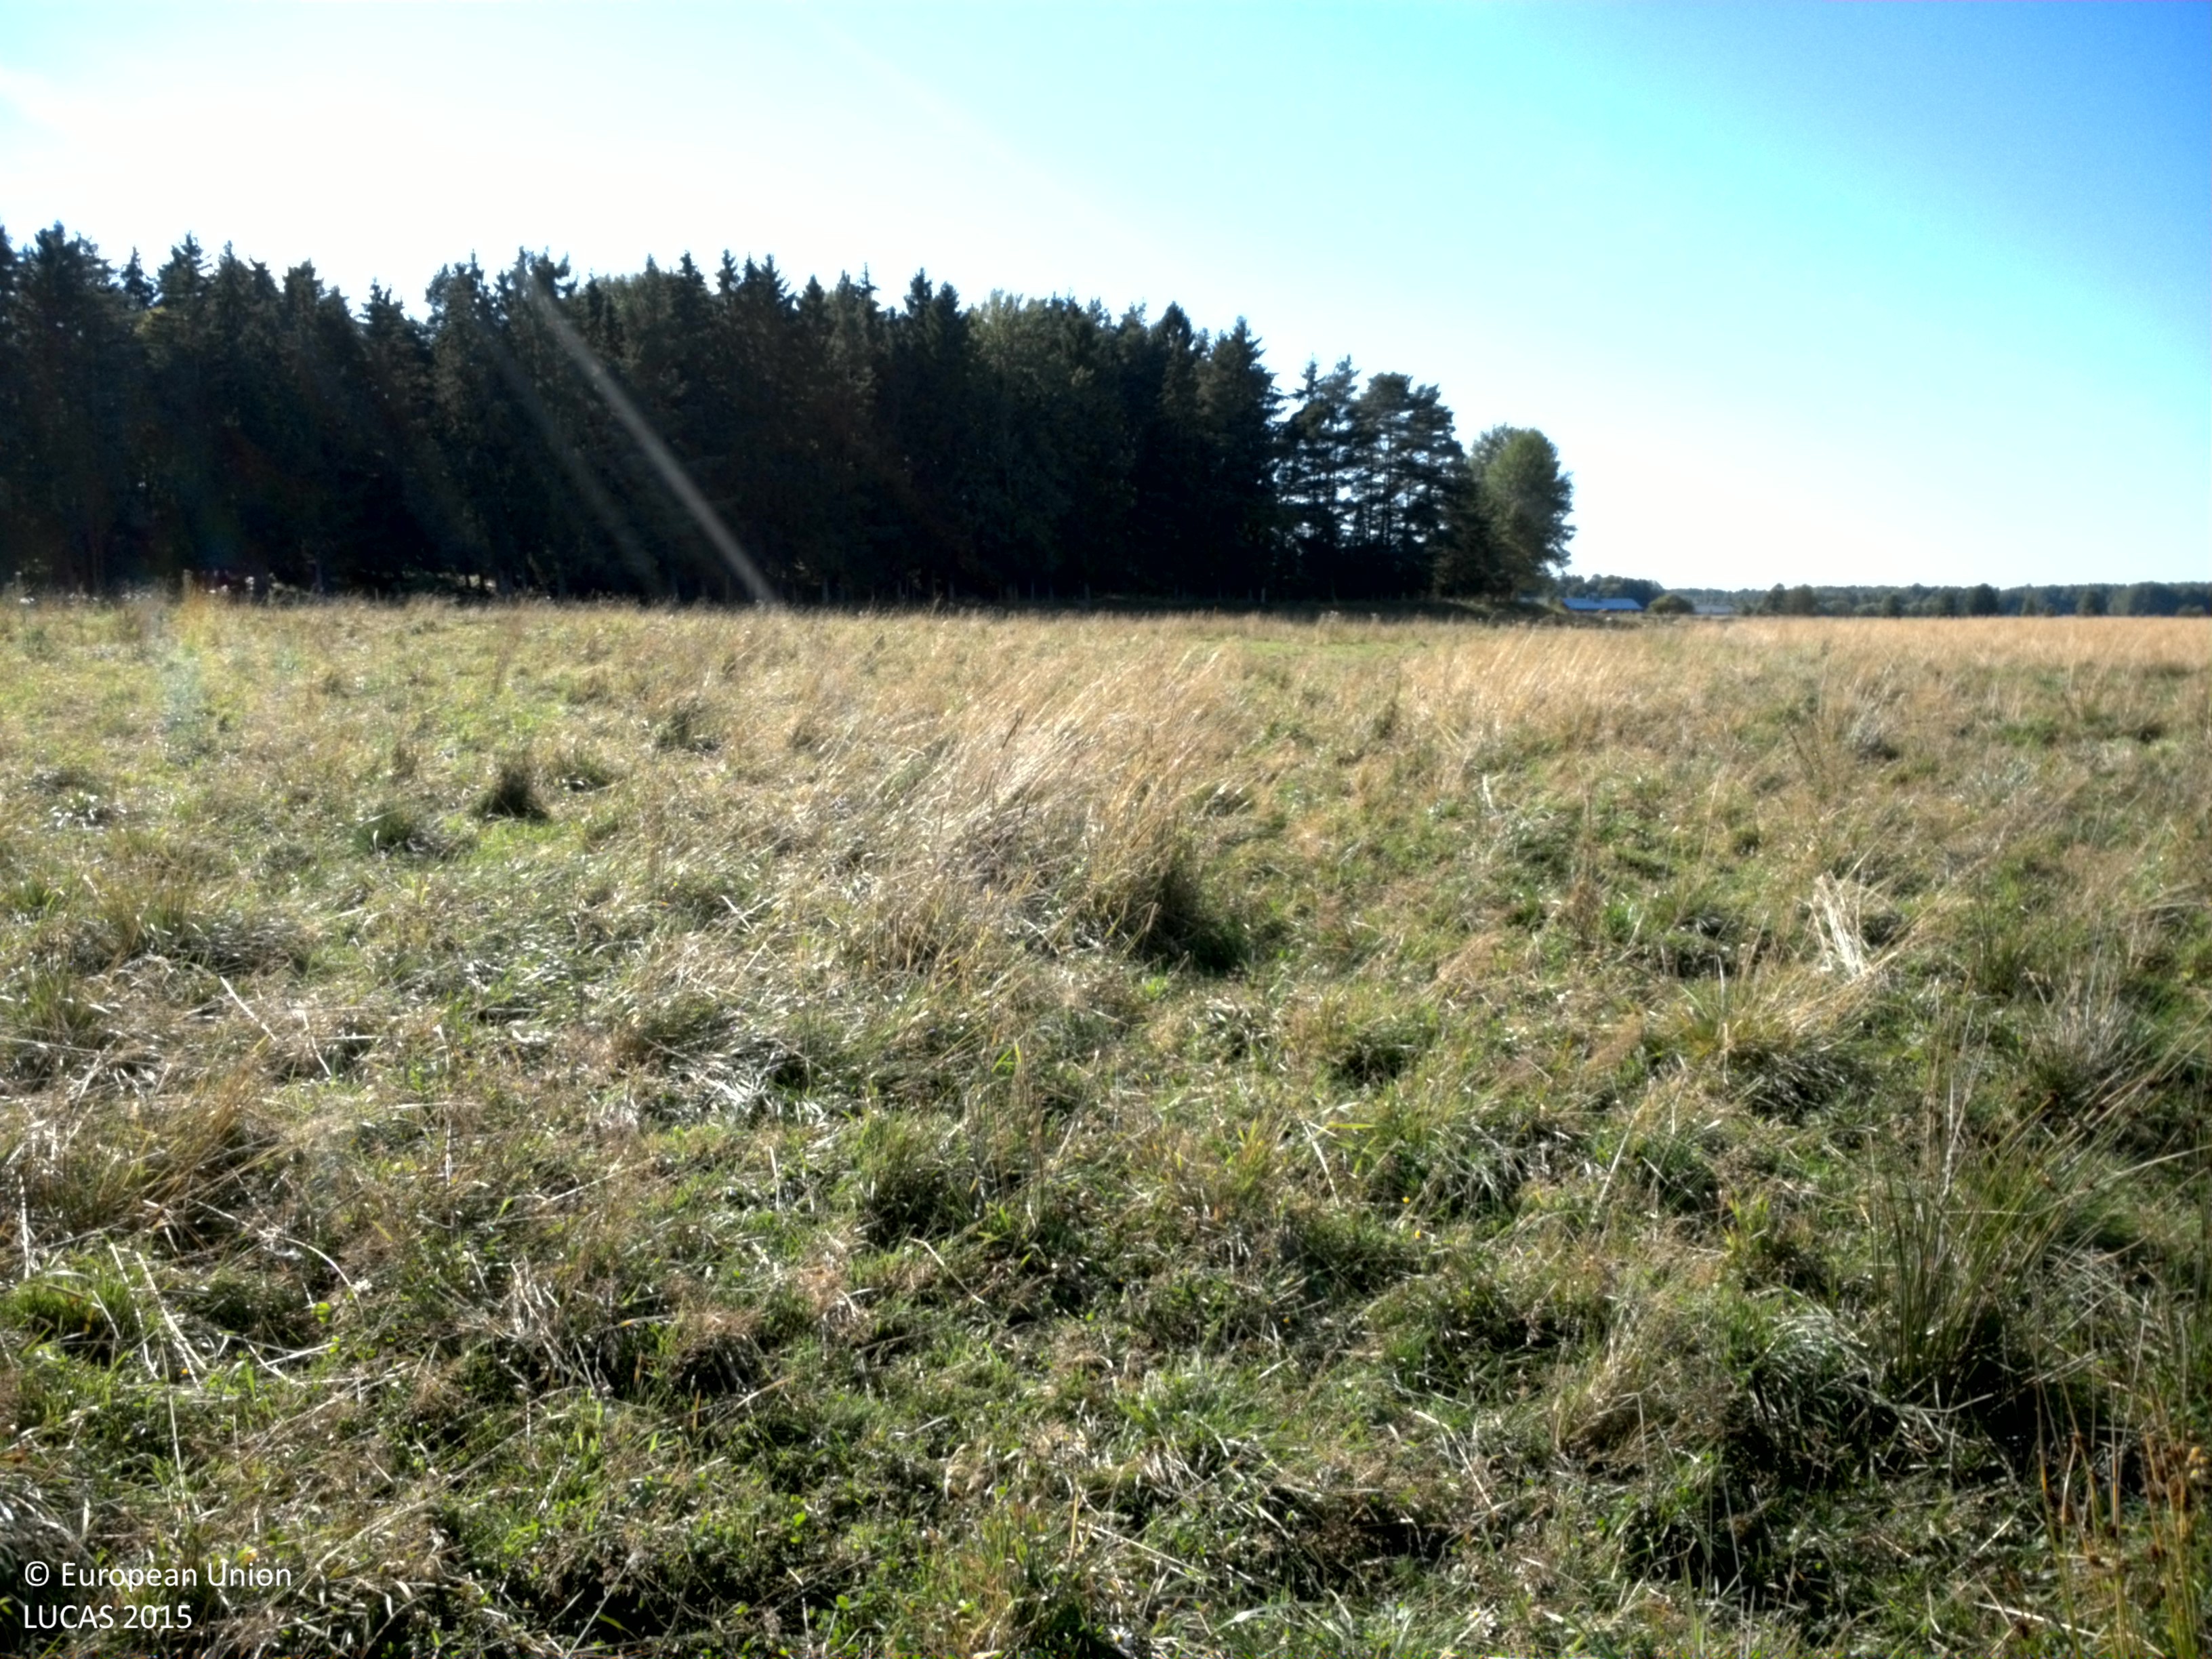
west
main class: Grassland
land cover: Grassland without tree/shrub cover
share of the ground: > 75 %
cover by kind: herbaceous plants 100 %
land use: Agriculture (excluding fallow land and kitchen gardens)
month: August
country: SE
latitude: 59.7937
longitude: 16.9241
